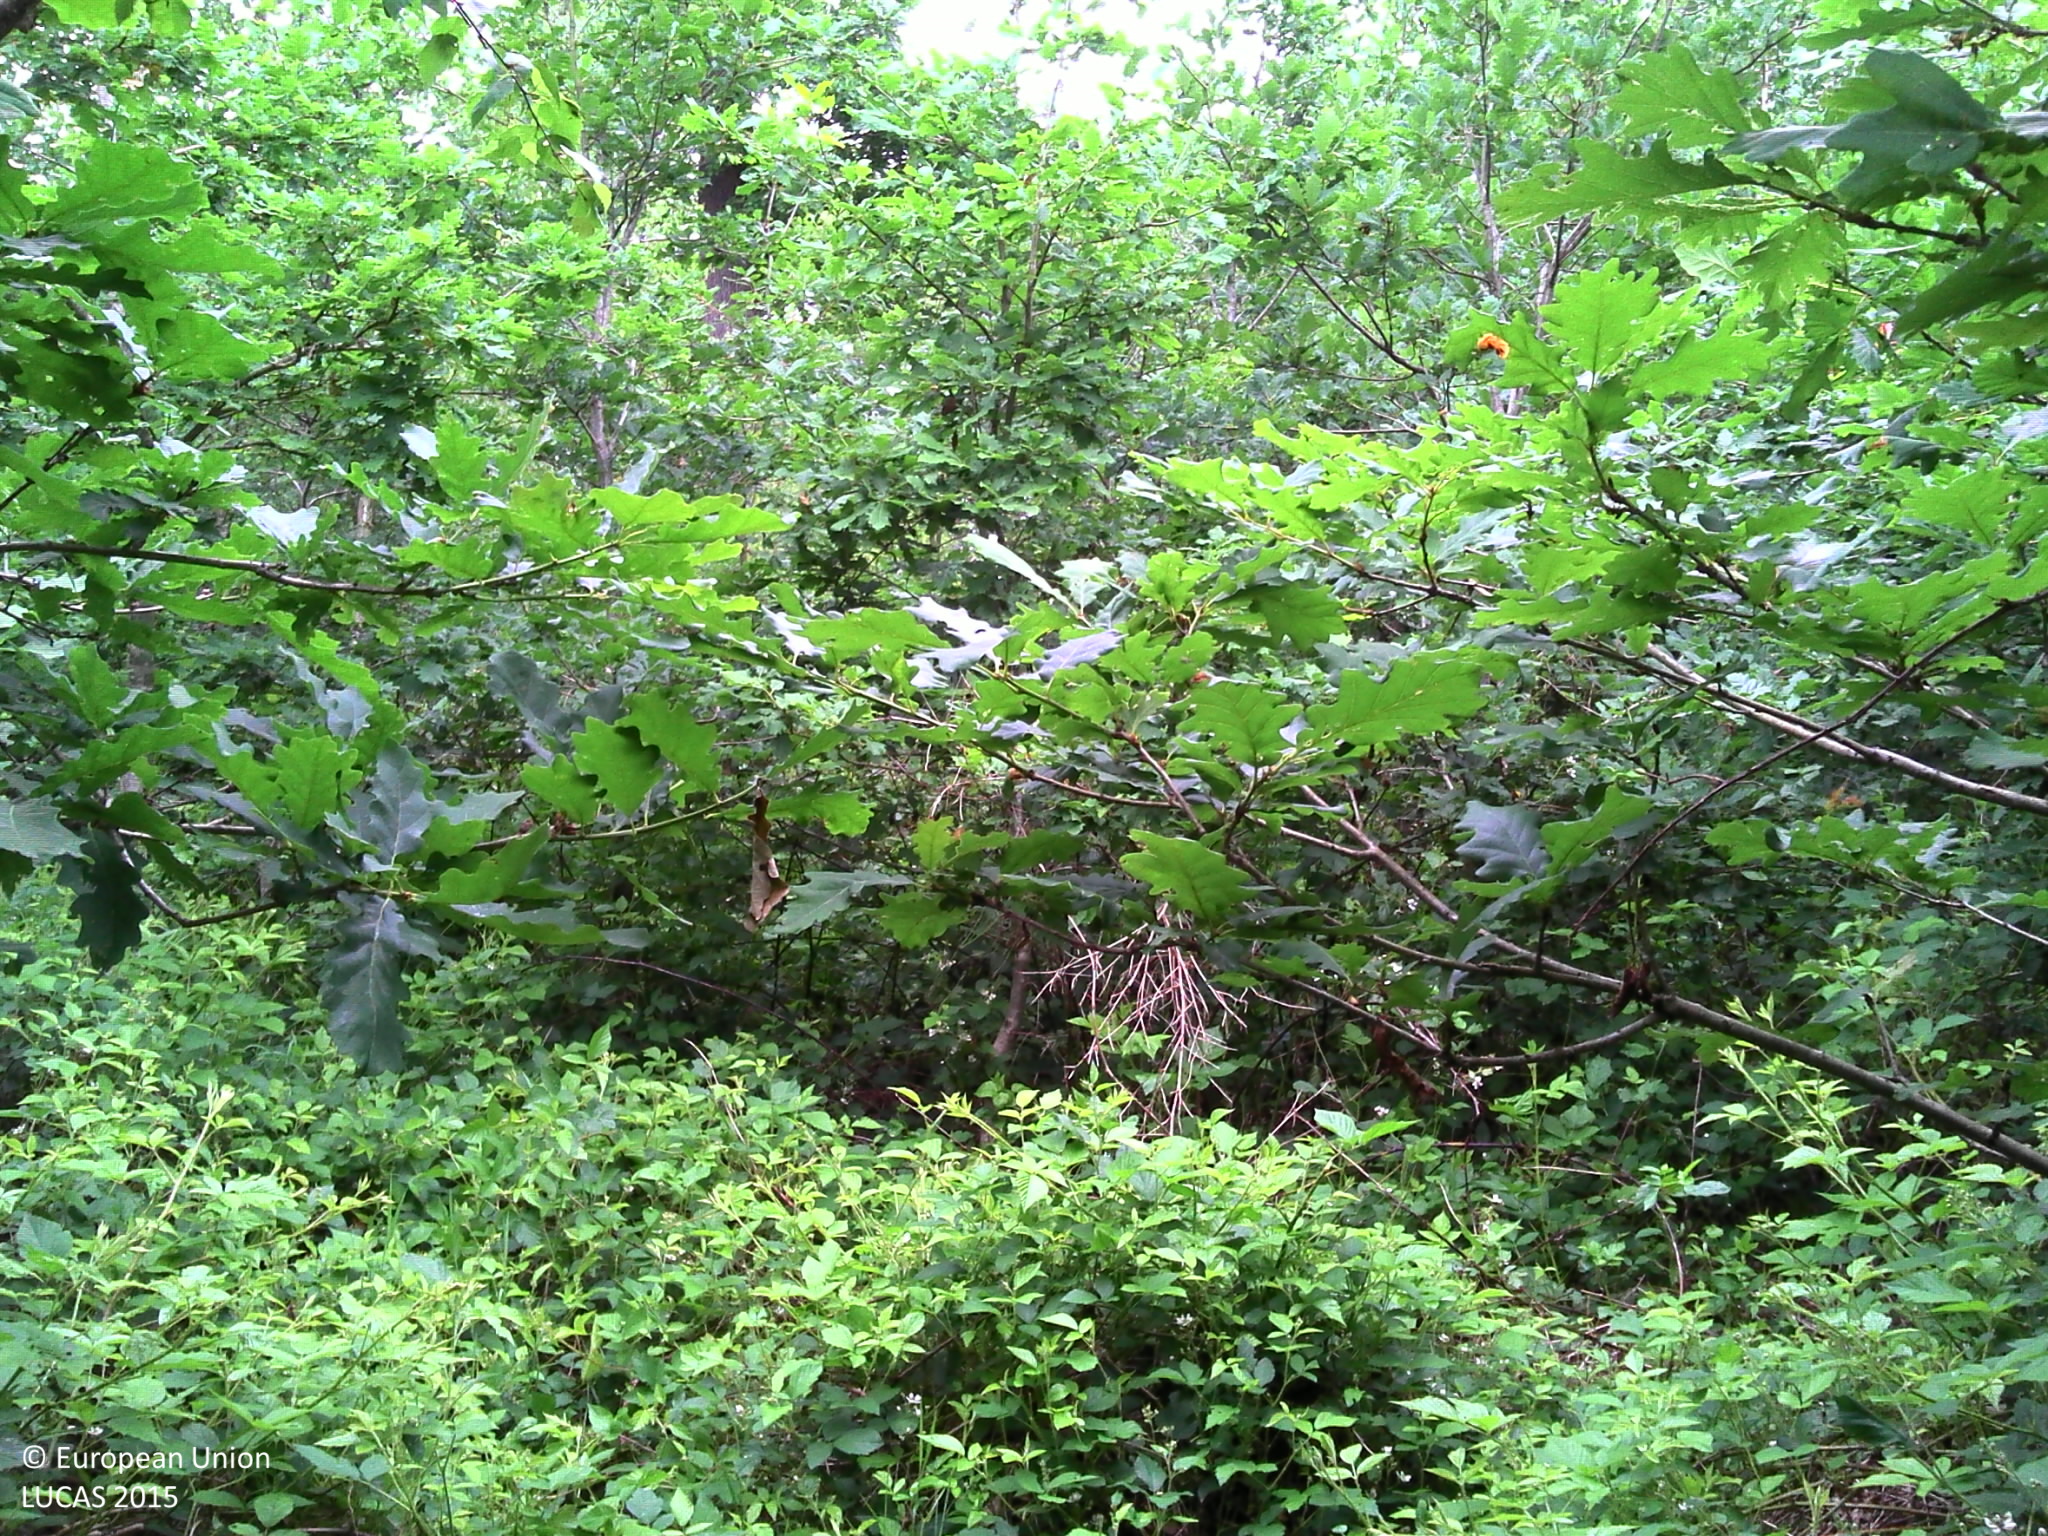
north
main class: Woodland
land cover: Spruce dominated coniferous woodland
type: alpine coniferous forest
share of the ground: > 75 %
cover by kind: coniferous forest trees 100 %
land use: Forestry
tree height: > 5 m
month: June
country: BE
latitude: 49.8739
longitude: 5.3645
